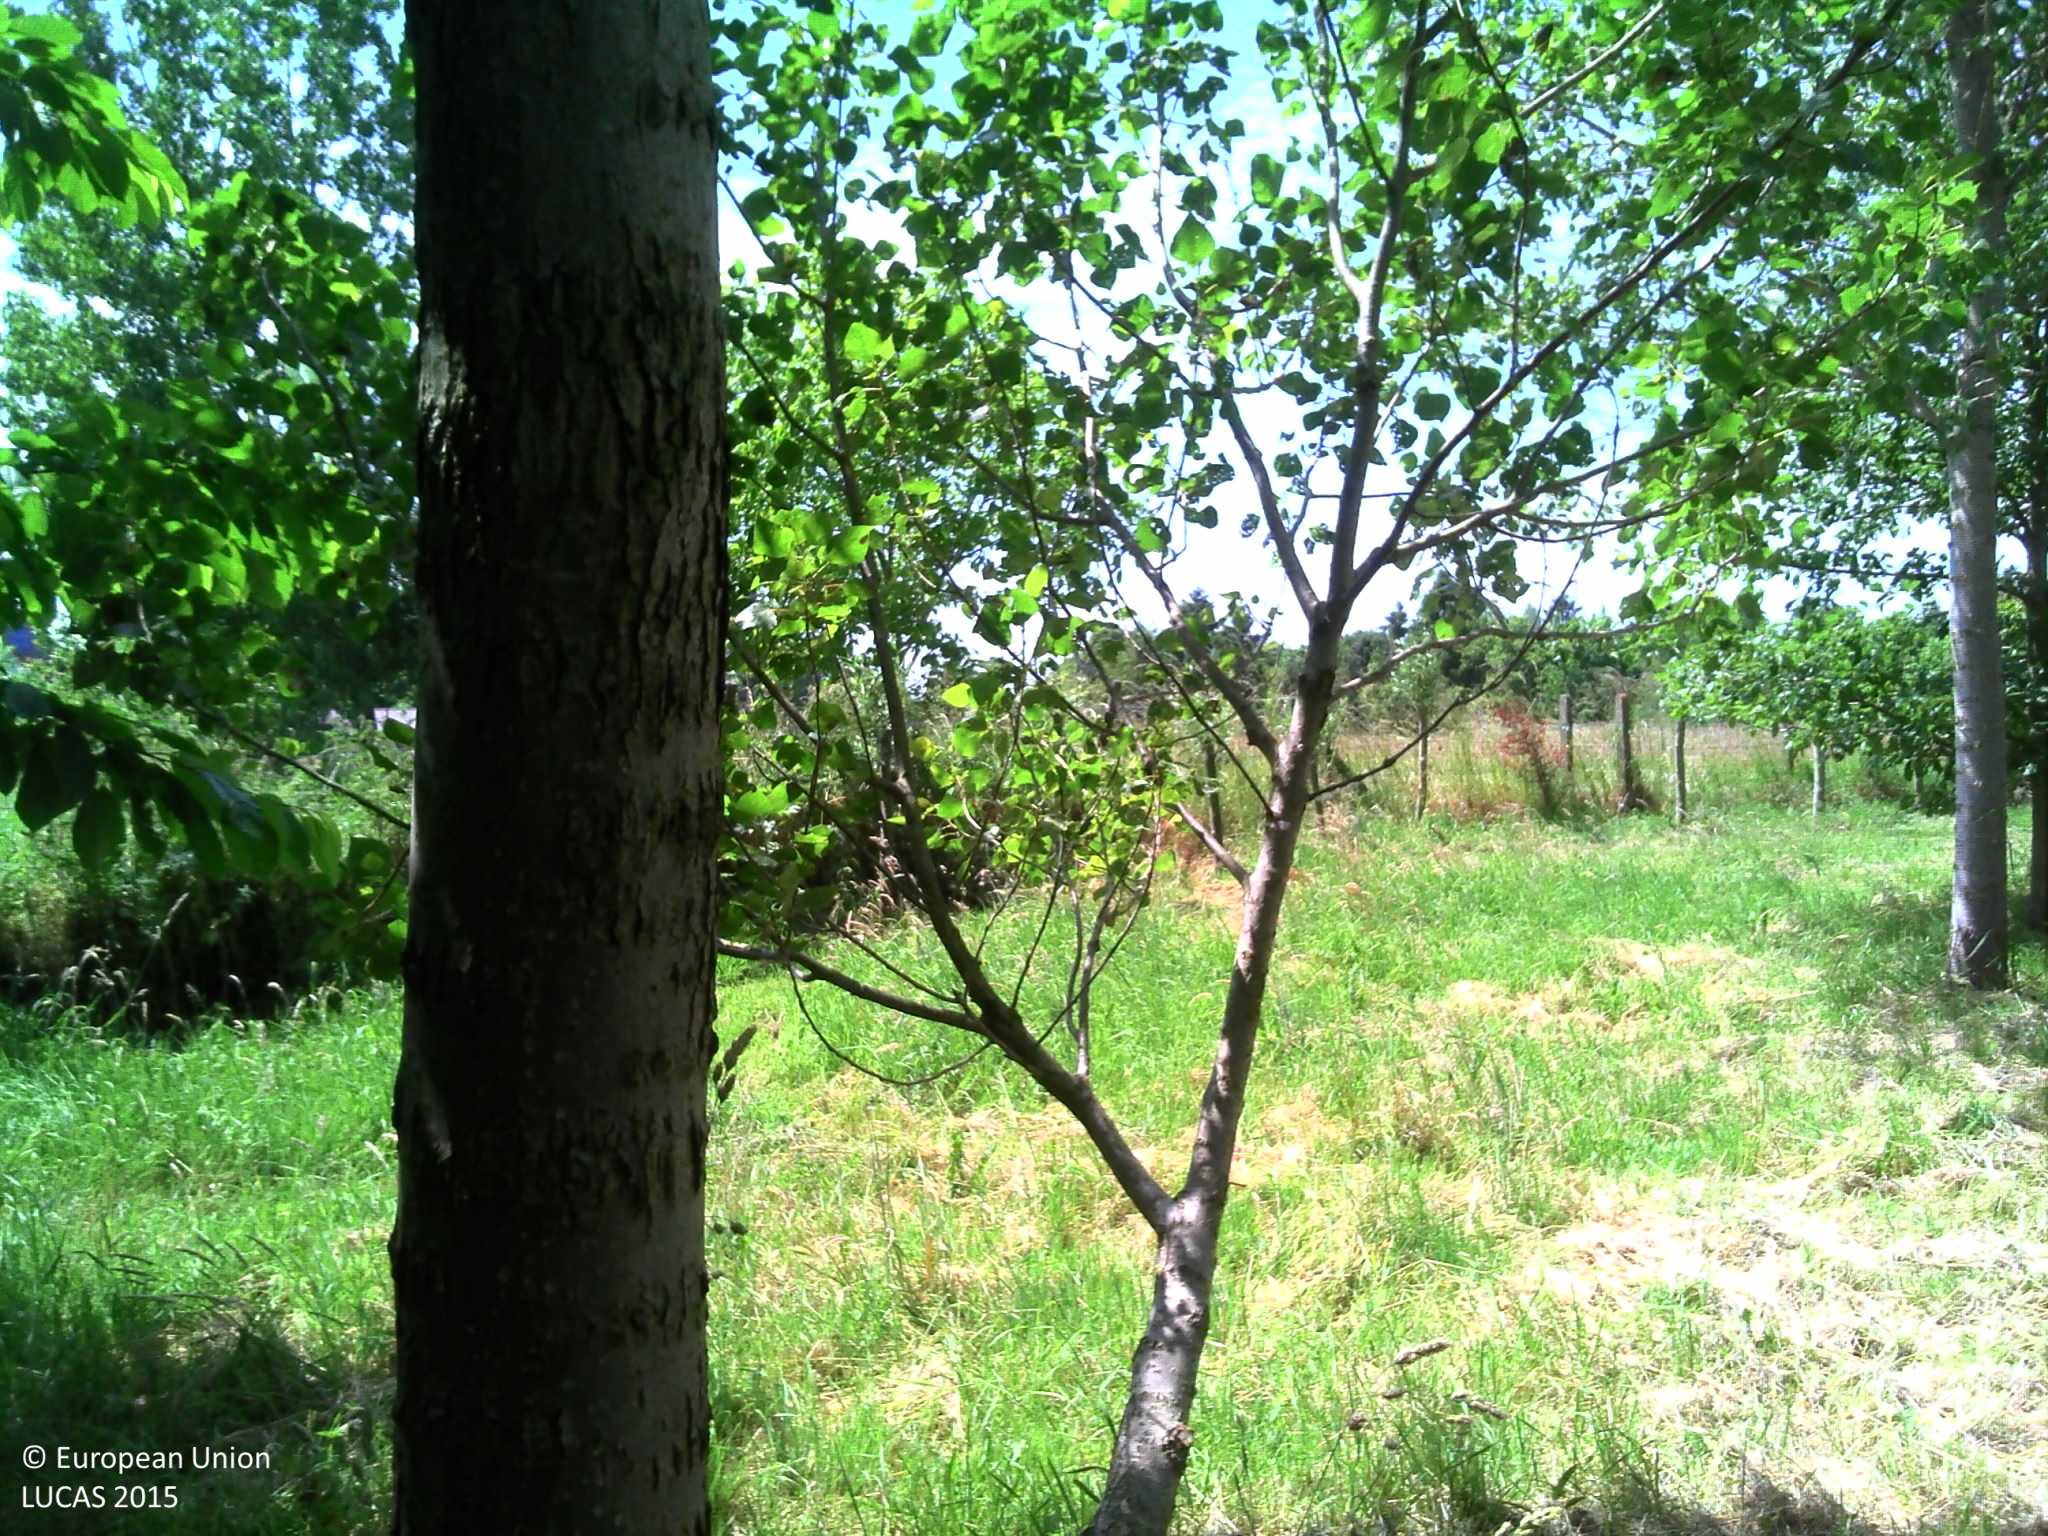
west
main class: Woodland
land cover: Broadleaved woodland
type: exotic forest
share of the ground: > 75 %
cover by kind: broadleaved forest trees 100 %
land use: Forestry
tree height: > 5 m
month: June
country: BE
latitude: 50.7456
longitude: 3.6295
